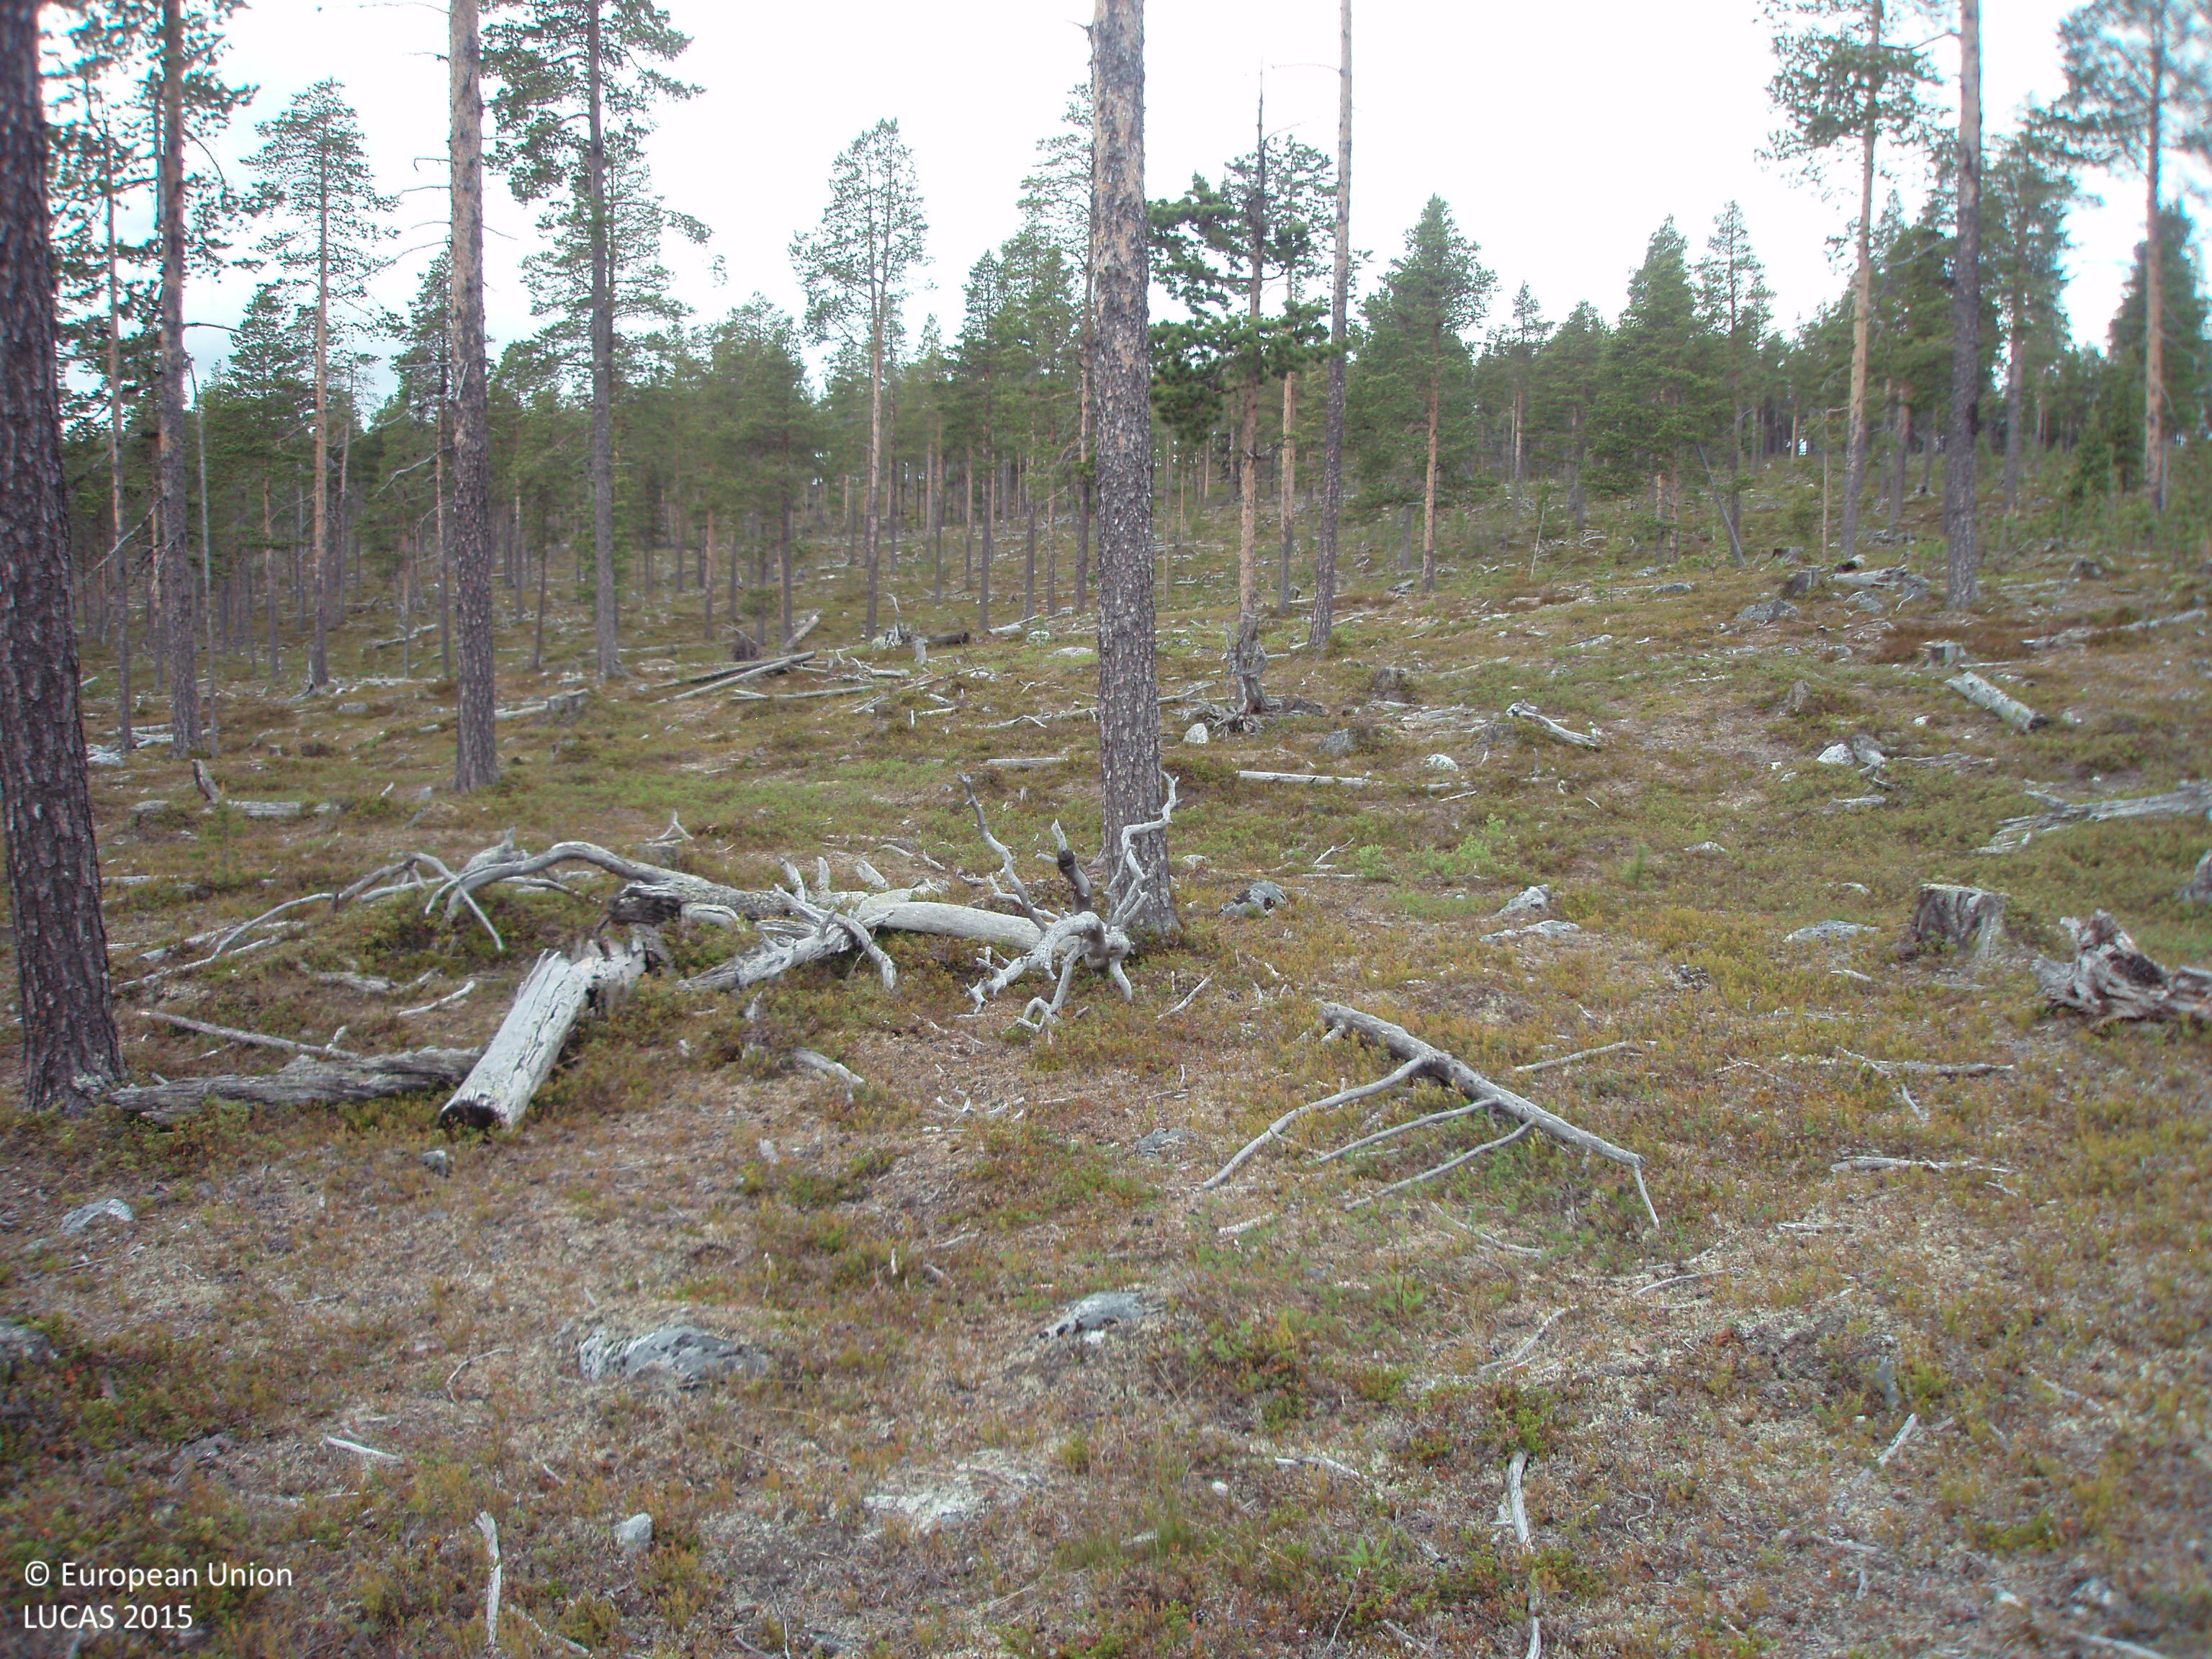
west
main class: Woodland
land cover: Pine dominated coniferous woodland
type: boreal forest
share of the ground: 10 - 25 %
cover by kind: shrubs 65 %, coniferous forest trees 15 %, lichens and mosses 15 %, unconsolidated bare surface 5 %
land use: Forestry
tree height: > 5 m
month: July
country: FI
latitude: 68.8783
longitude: 25.9249
